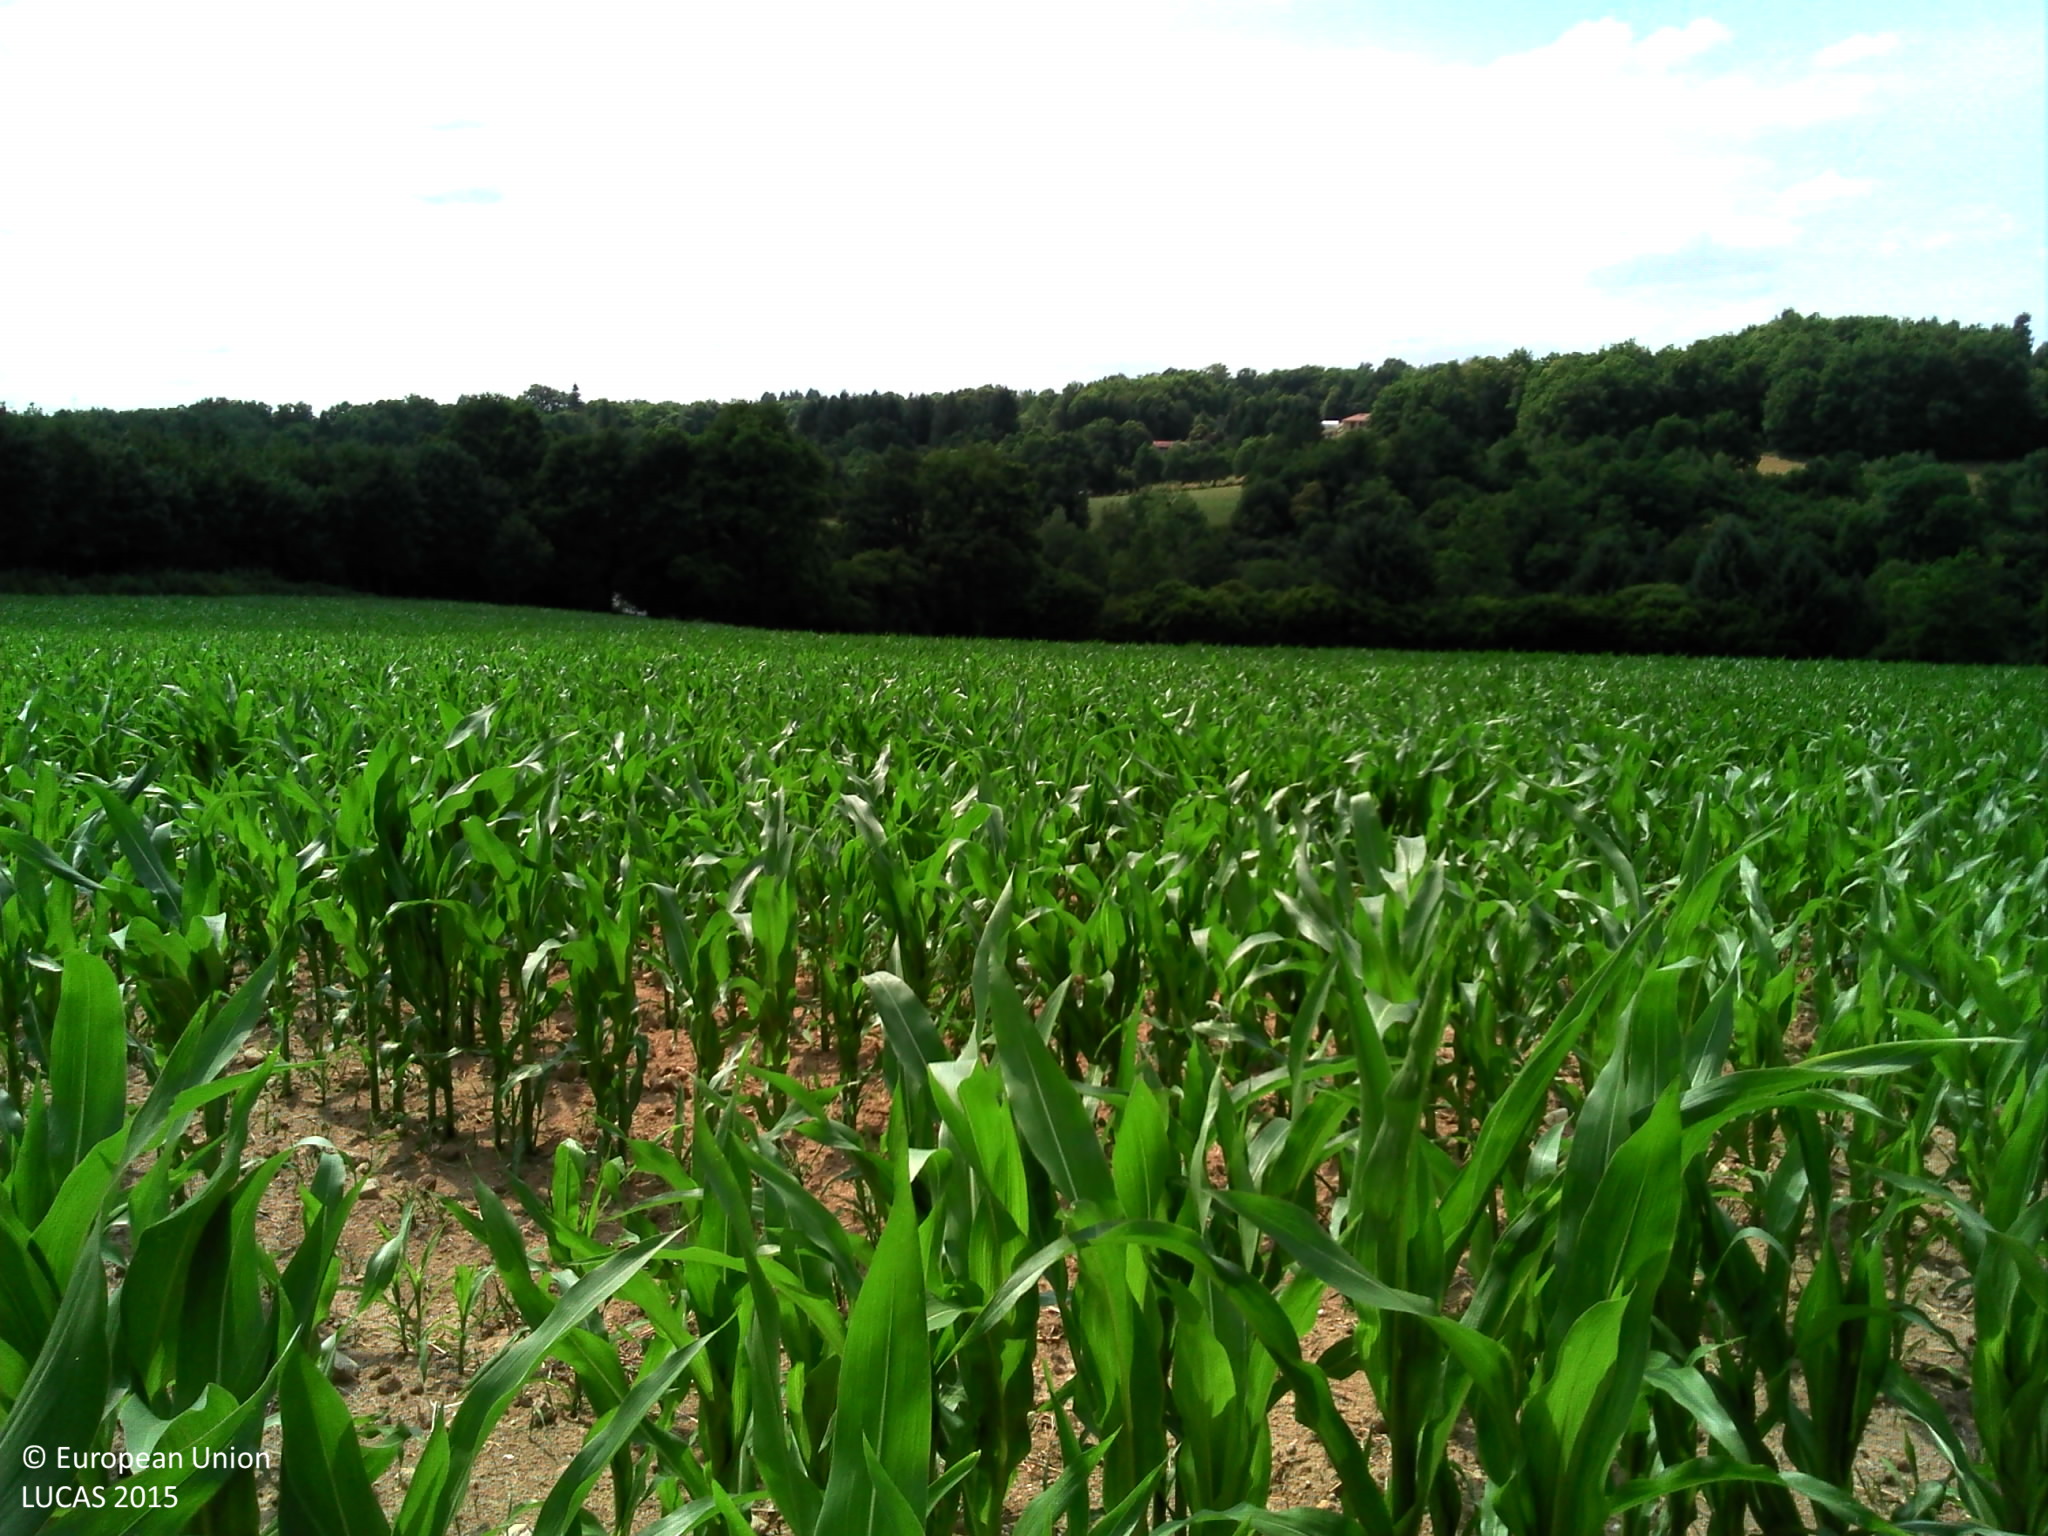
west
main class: Cropland
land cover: Maize
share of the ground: > 75 %
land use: Agriculture (excluding fallow land and kitchen gardens)
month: July
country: FR
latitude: 45.7252
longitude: 0.6717
